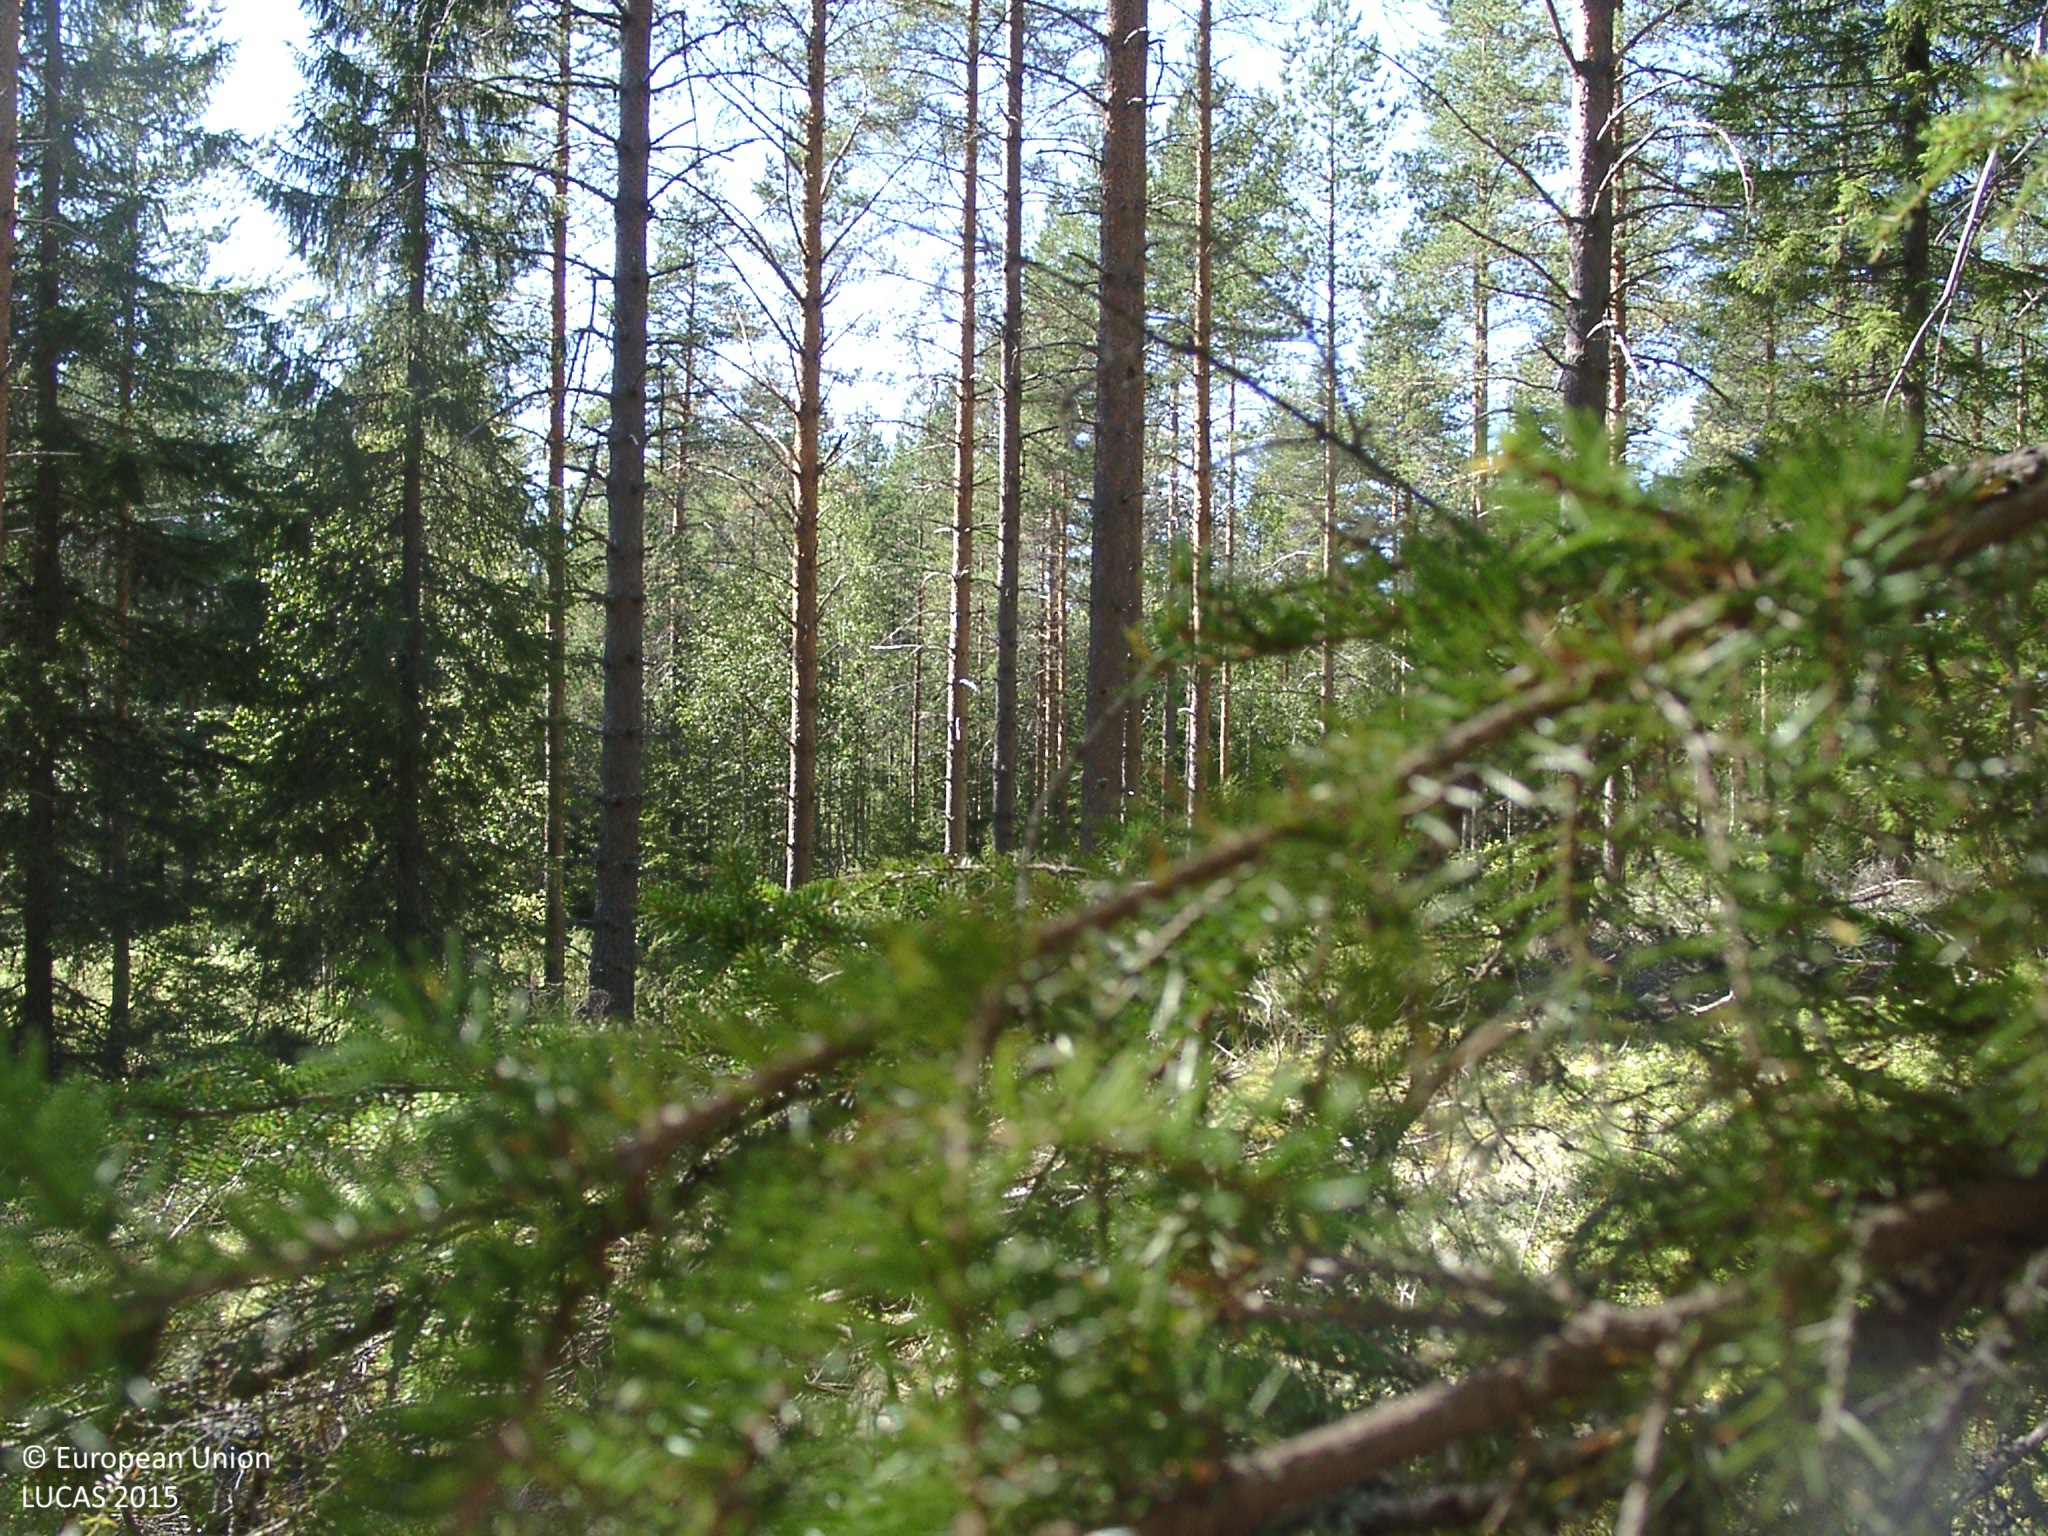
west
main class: Woodland
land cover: Other coniferous woodland
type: boreal forest
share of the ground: 50 - 75 %
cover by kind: coniferous forest trees 50 %, shrubs 30 %, lichens and mosses 15 %, broadleaved forest trees 5 %
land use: Forestry
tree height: > 5 m
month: August
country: FI
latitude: 62.4714
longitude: 25.0942
